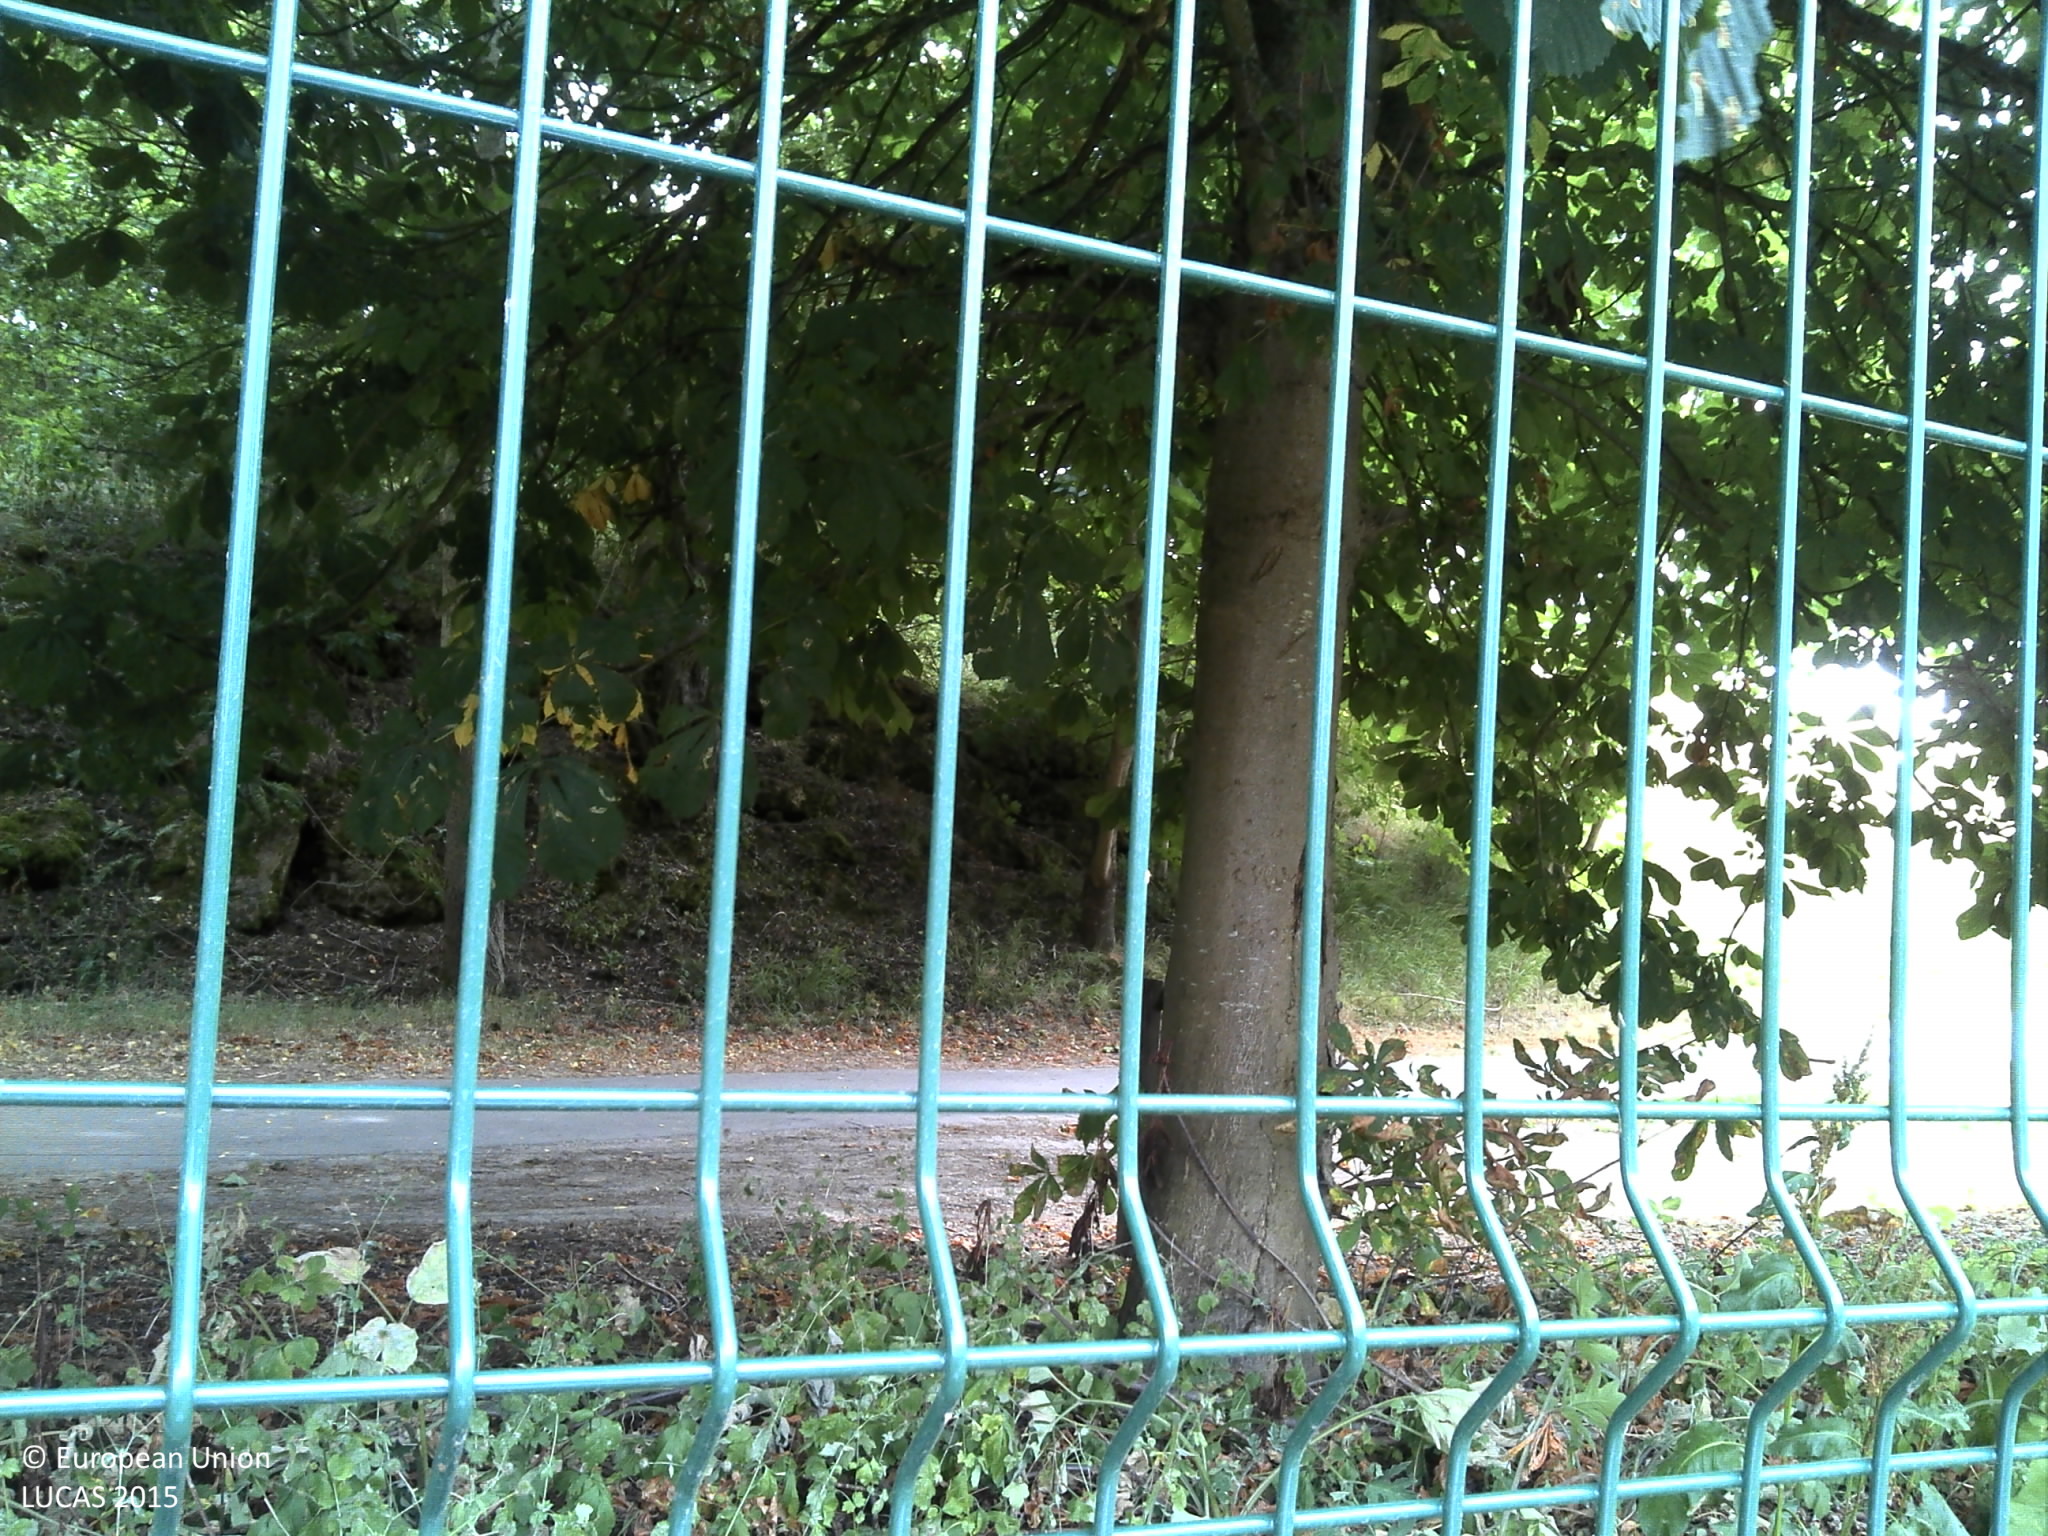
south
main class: Woodland
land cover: Broadleaved woodland
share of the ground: > 75 %
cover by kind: broadleaved forest trees 50 %, herbaceous plants 35 %, consolidated bare surface 15 %
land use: Sport
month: July
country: FR
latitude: 48.6354
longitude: 2.4849
